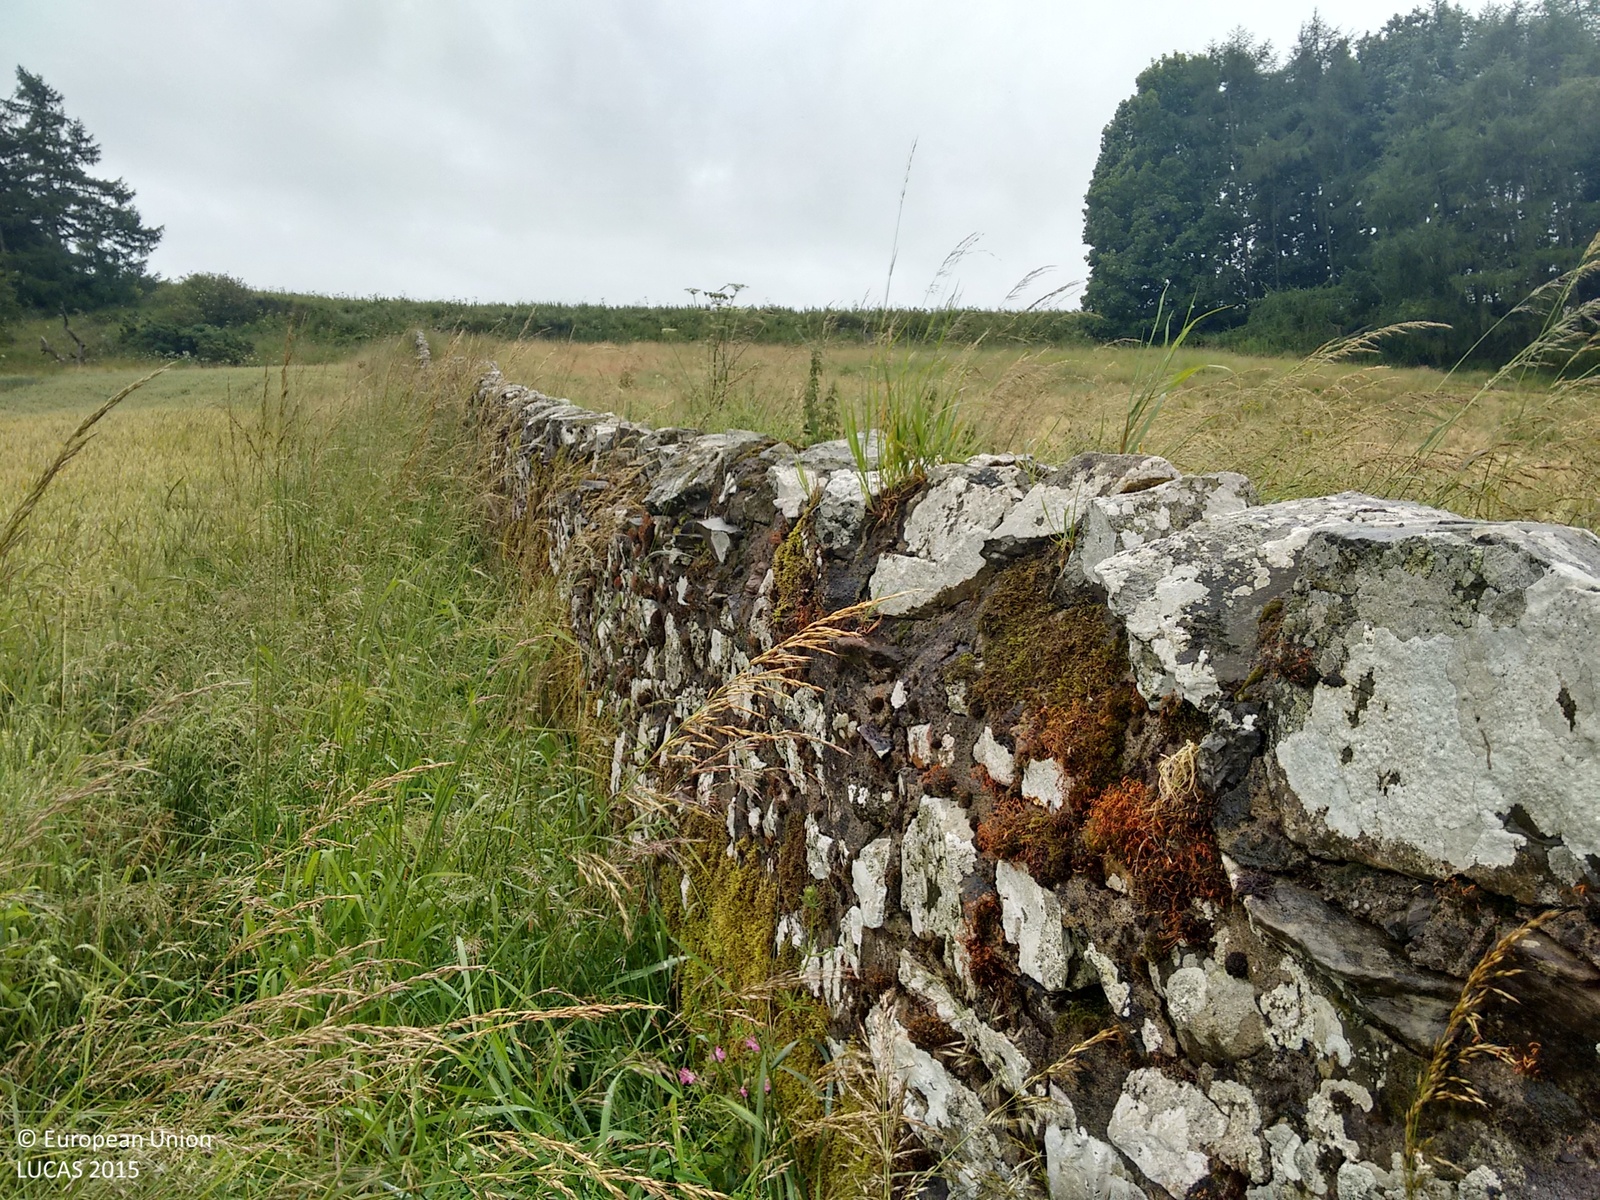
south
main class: Cropland
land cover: Common wheat
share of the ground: > 75 %
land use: Agriculture (excluding fallow land and kitchen gardens)
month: July
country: GB
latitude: 56.3907
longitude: -3.0752
